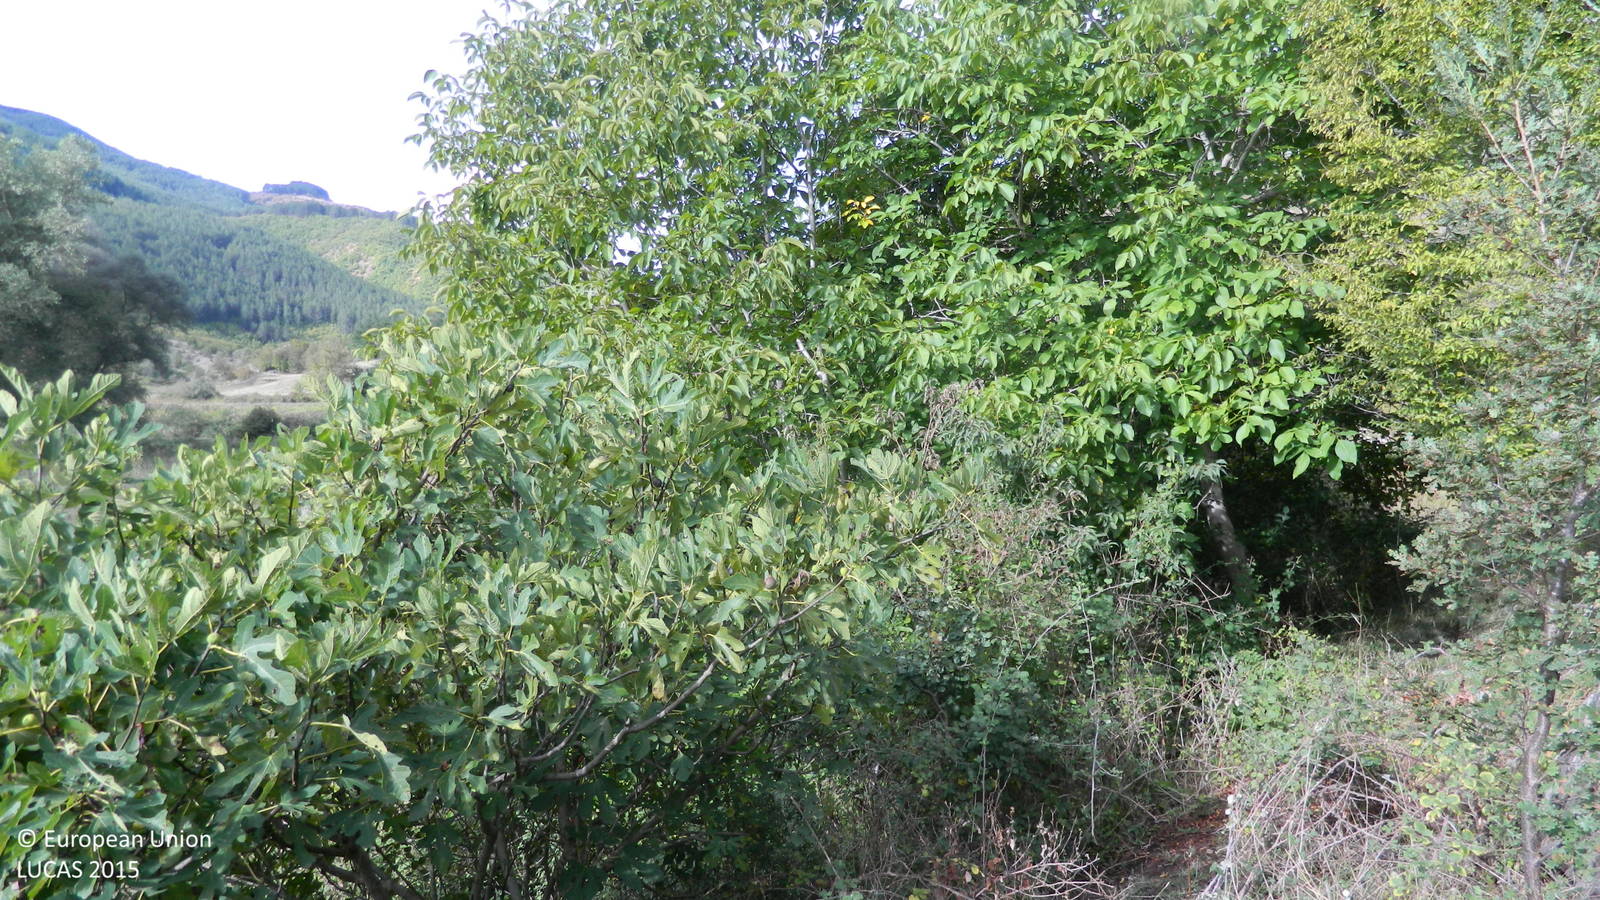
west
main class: Shrubland
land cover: Shrubland with sparse tree cover
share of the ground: > 75 %
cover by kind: shrubs 70 %, unconsolidated bare surface 15 %, herbaceous plants 10 %, broadleaved forest trees 5 %
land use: Abandoned areas
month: September
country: BG
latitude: 41.4741
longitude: 24.0057
